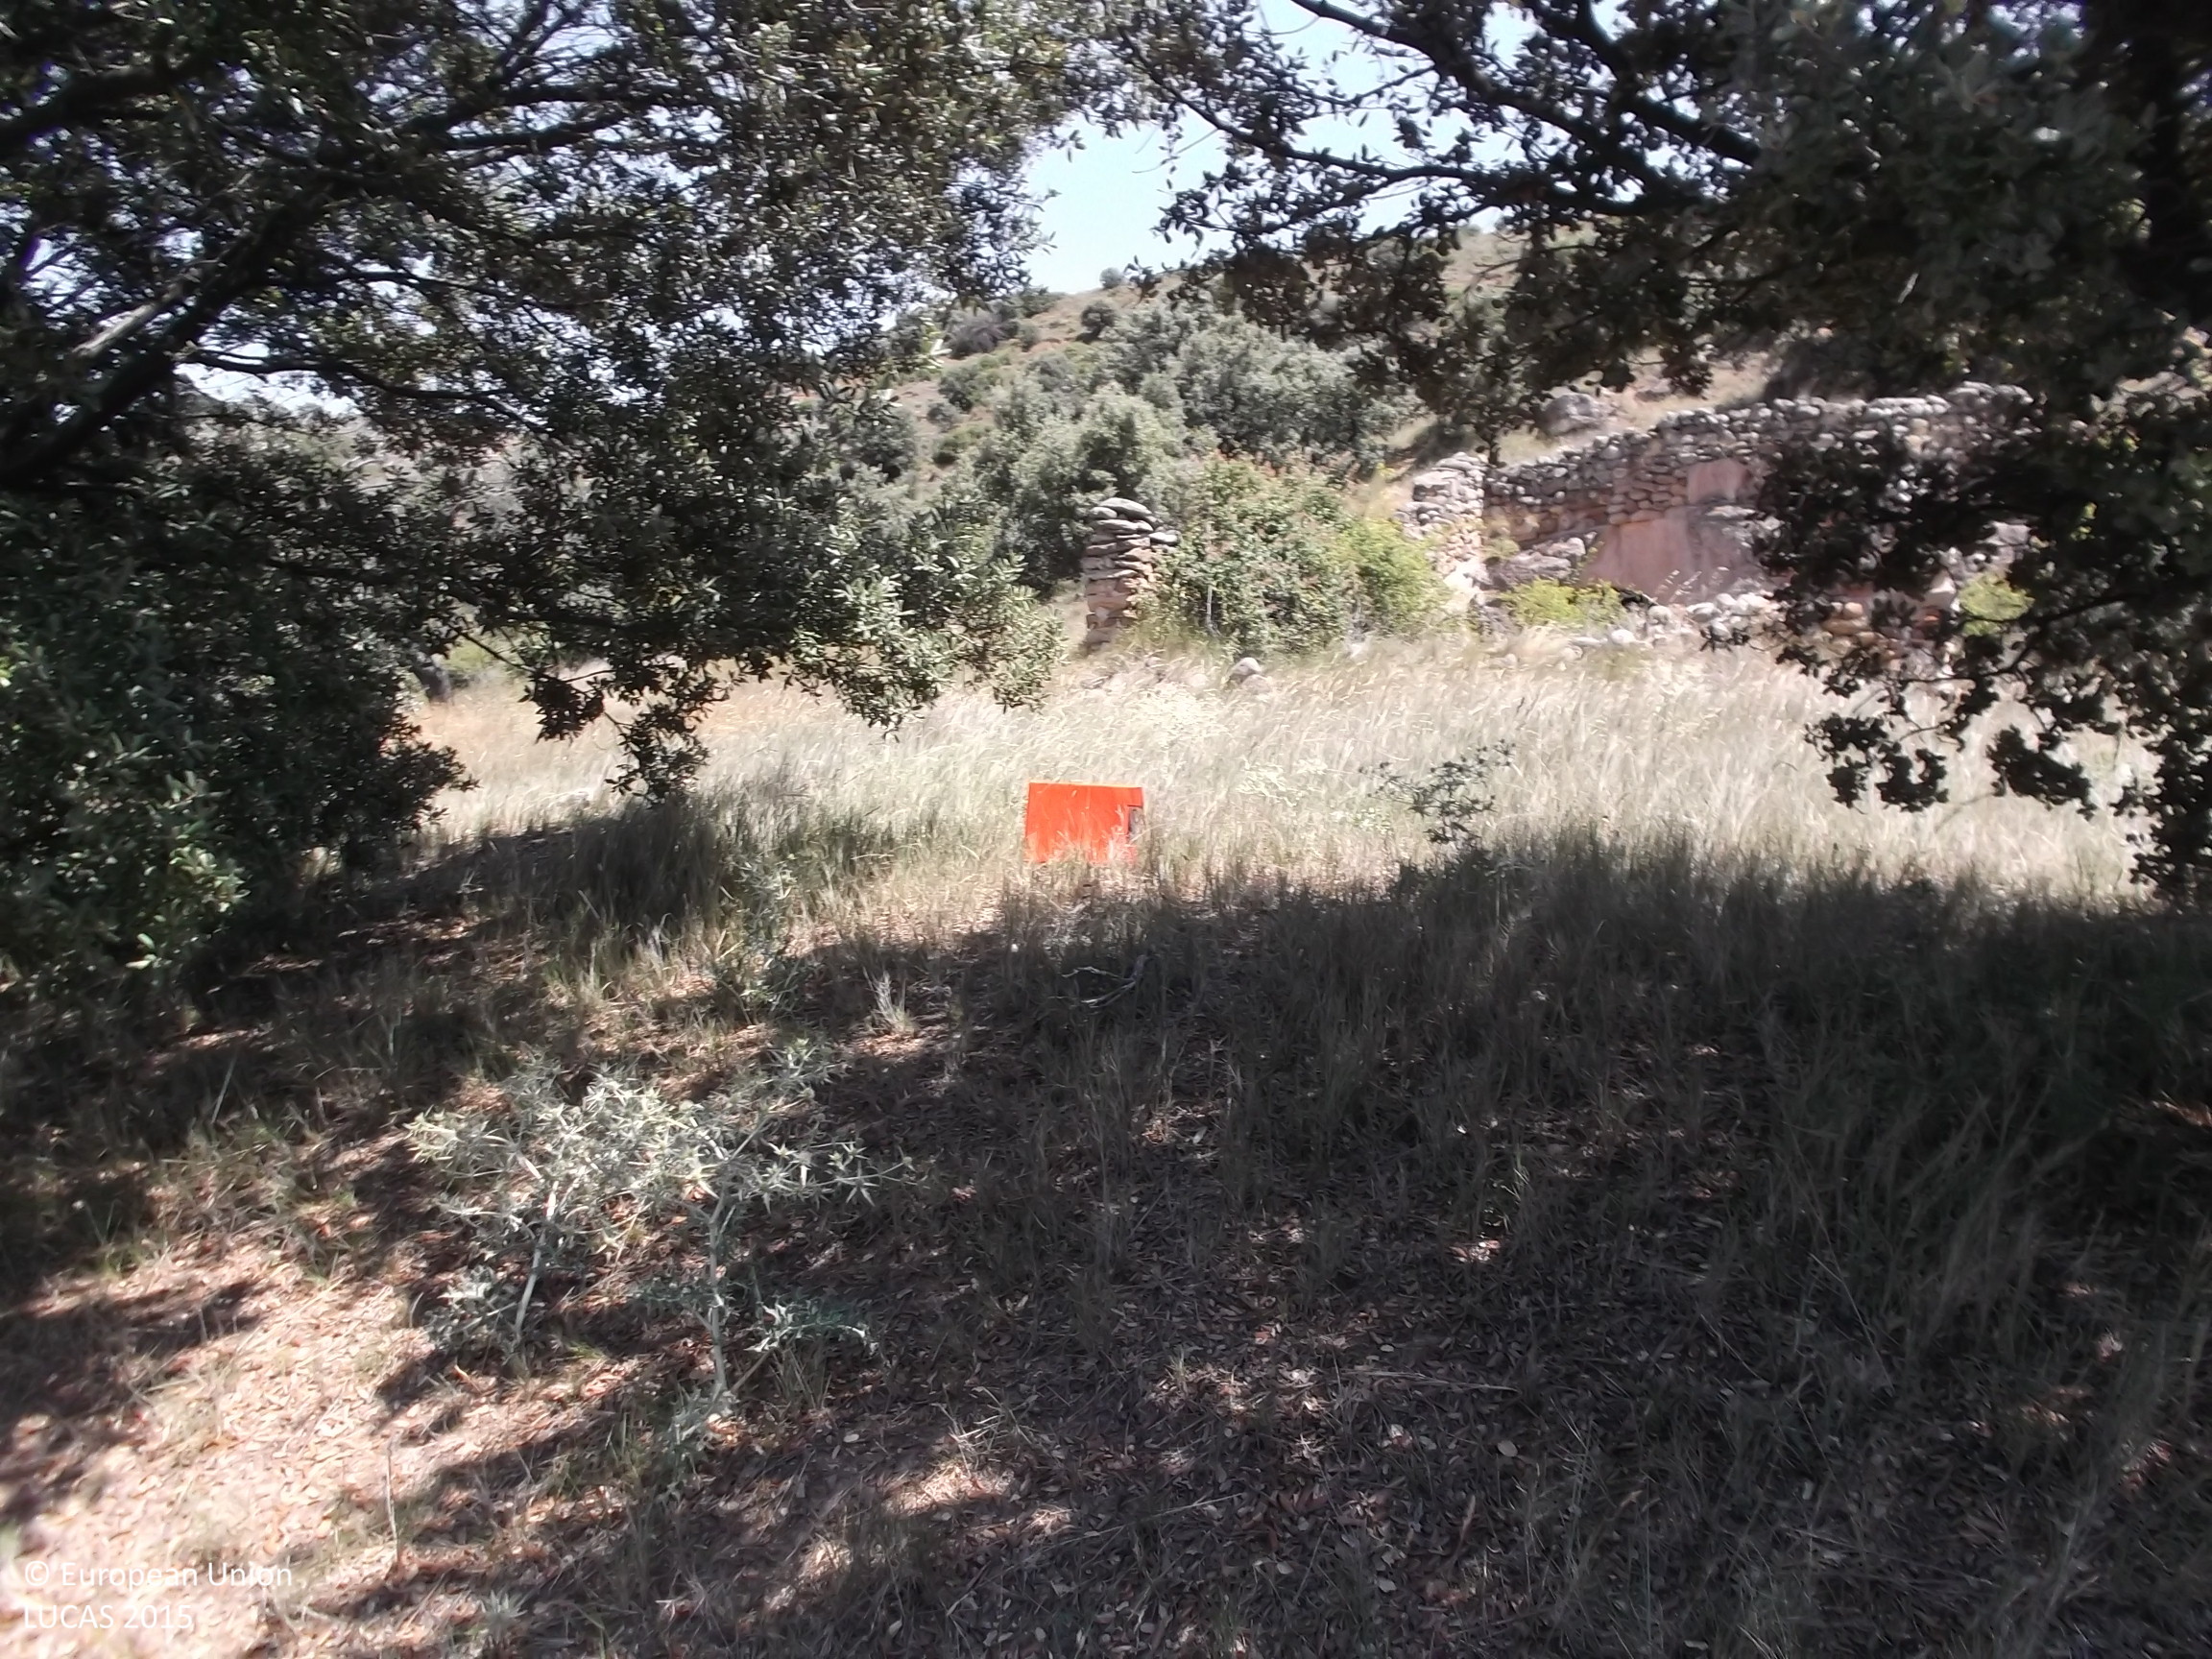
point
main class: Woodland
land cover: Broadleaved woodland
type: broadleaved evergreen forest
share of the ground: 10 - 25 %
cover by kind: herbaceous plants 60 %, shrubs 20 %, broadleaved forest trees 15 %, unconsolidated bare surface 5 %
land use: Semi-natural and natural areas not in use
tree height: > 5 m
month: July
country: ES
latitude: 42.1680
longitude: -2.0574
